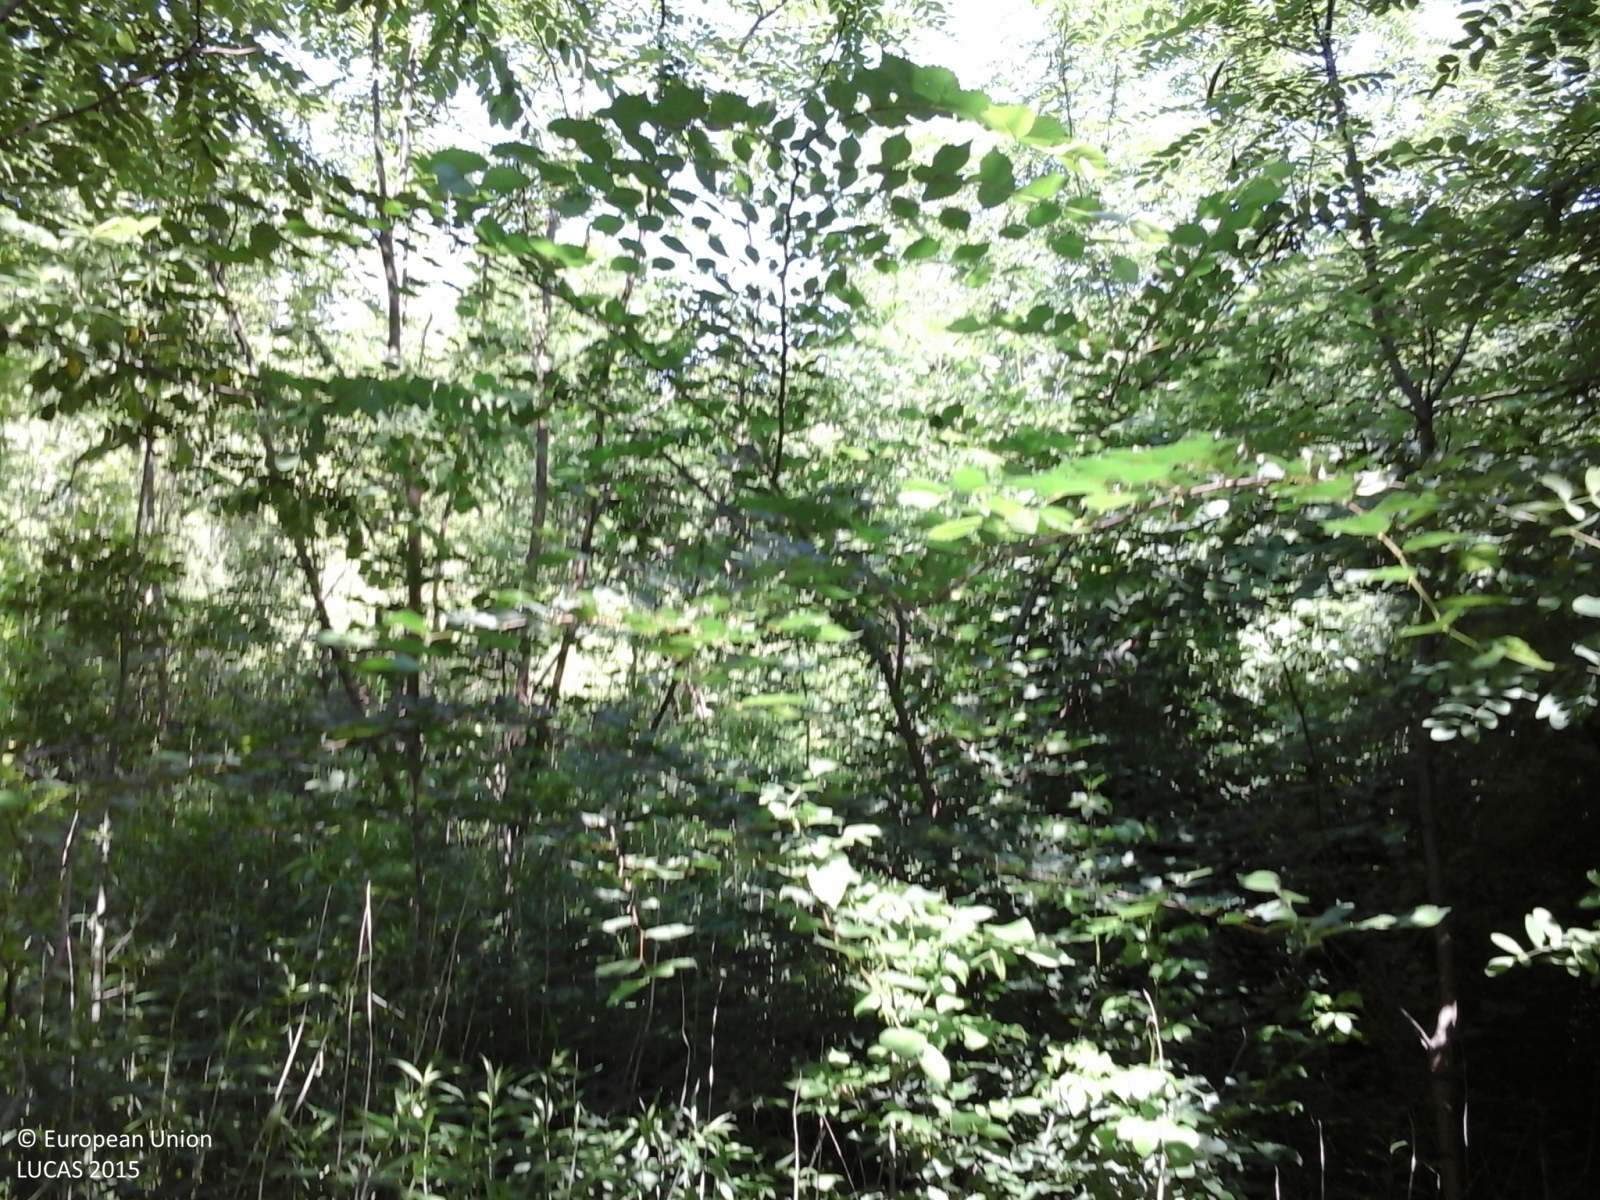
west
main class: Woodland
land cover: Broadleaved woodland
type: mesophytic deciduous forest
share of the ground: > 75 %
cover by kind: broadleaved forest trees 85 %, shrubs 10 %, herbaceous plants 5 %
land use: Forestry
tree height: > 5 m
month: June
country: IT
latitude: 44.6437
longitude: 8.3266
